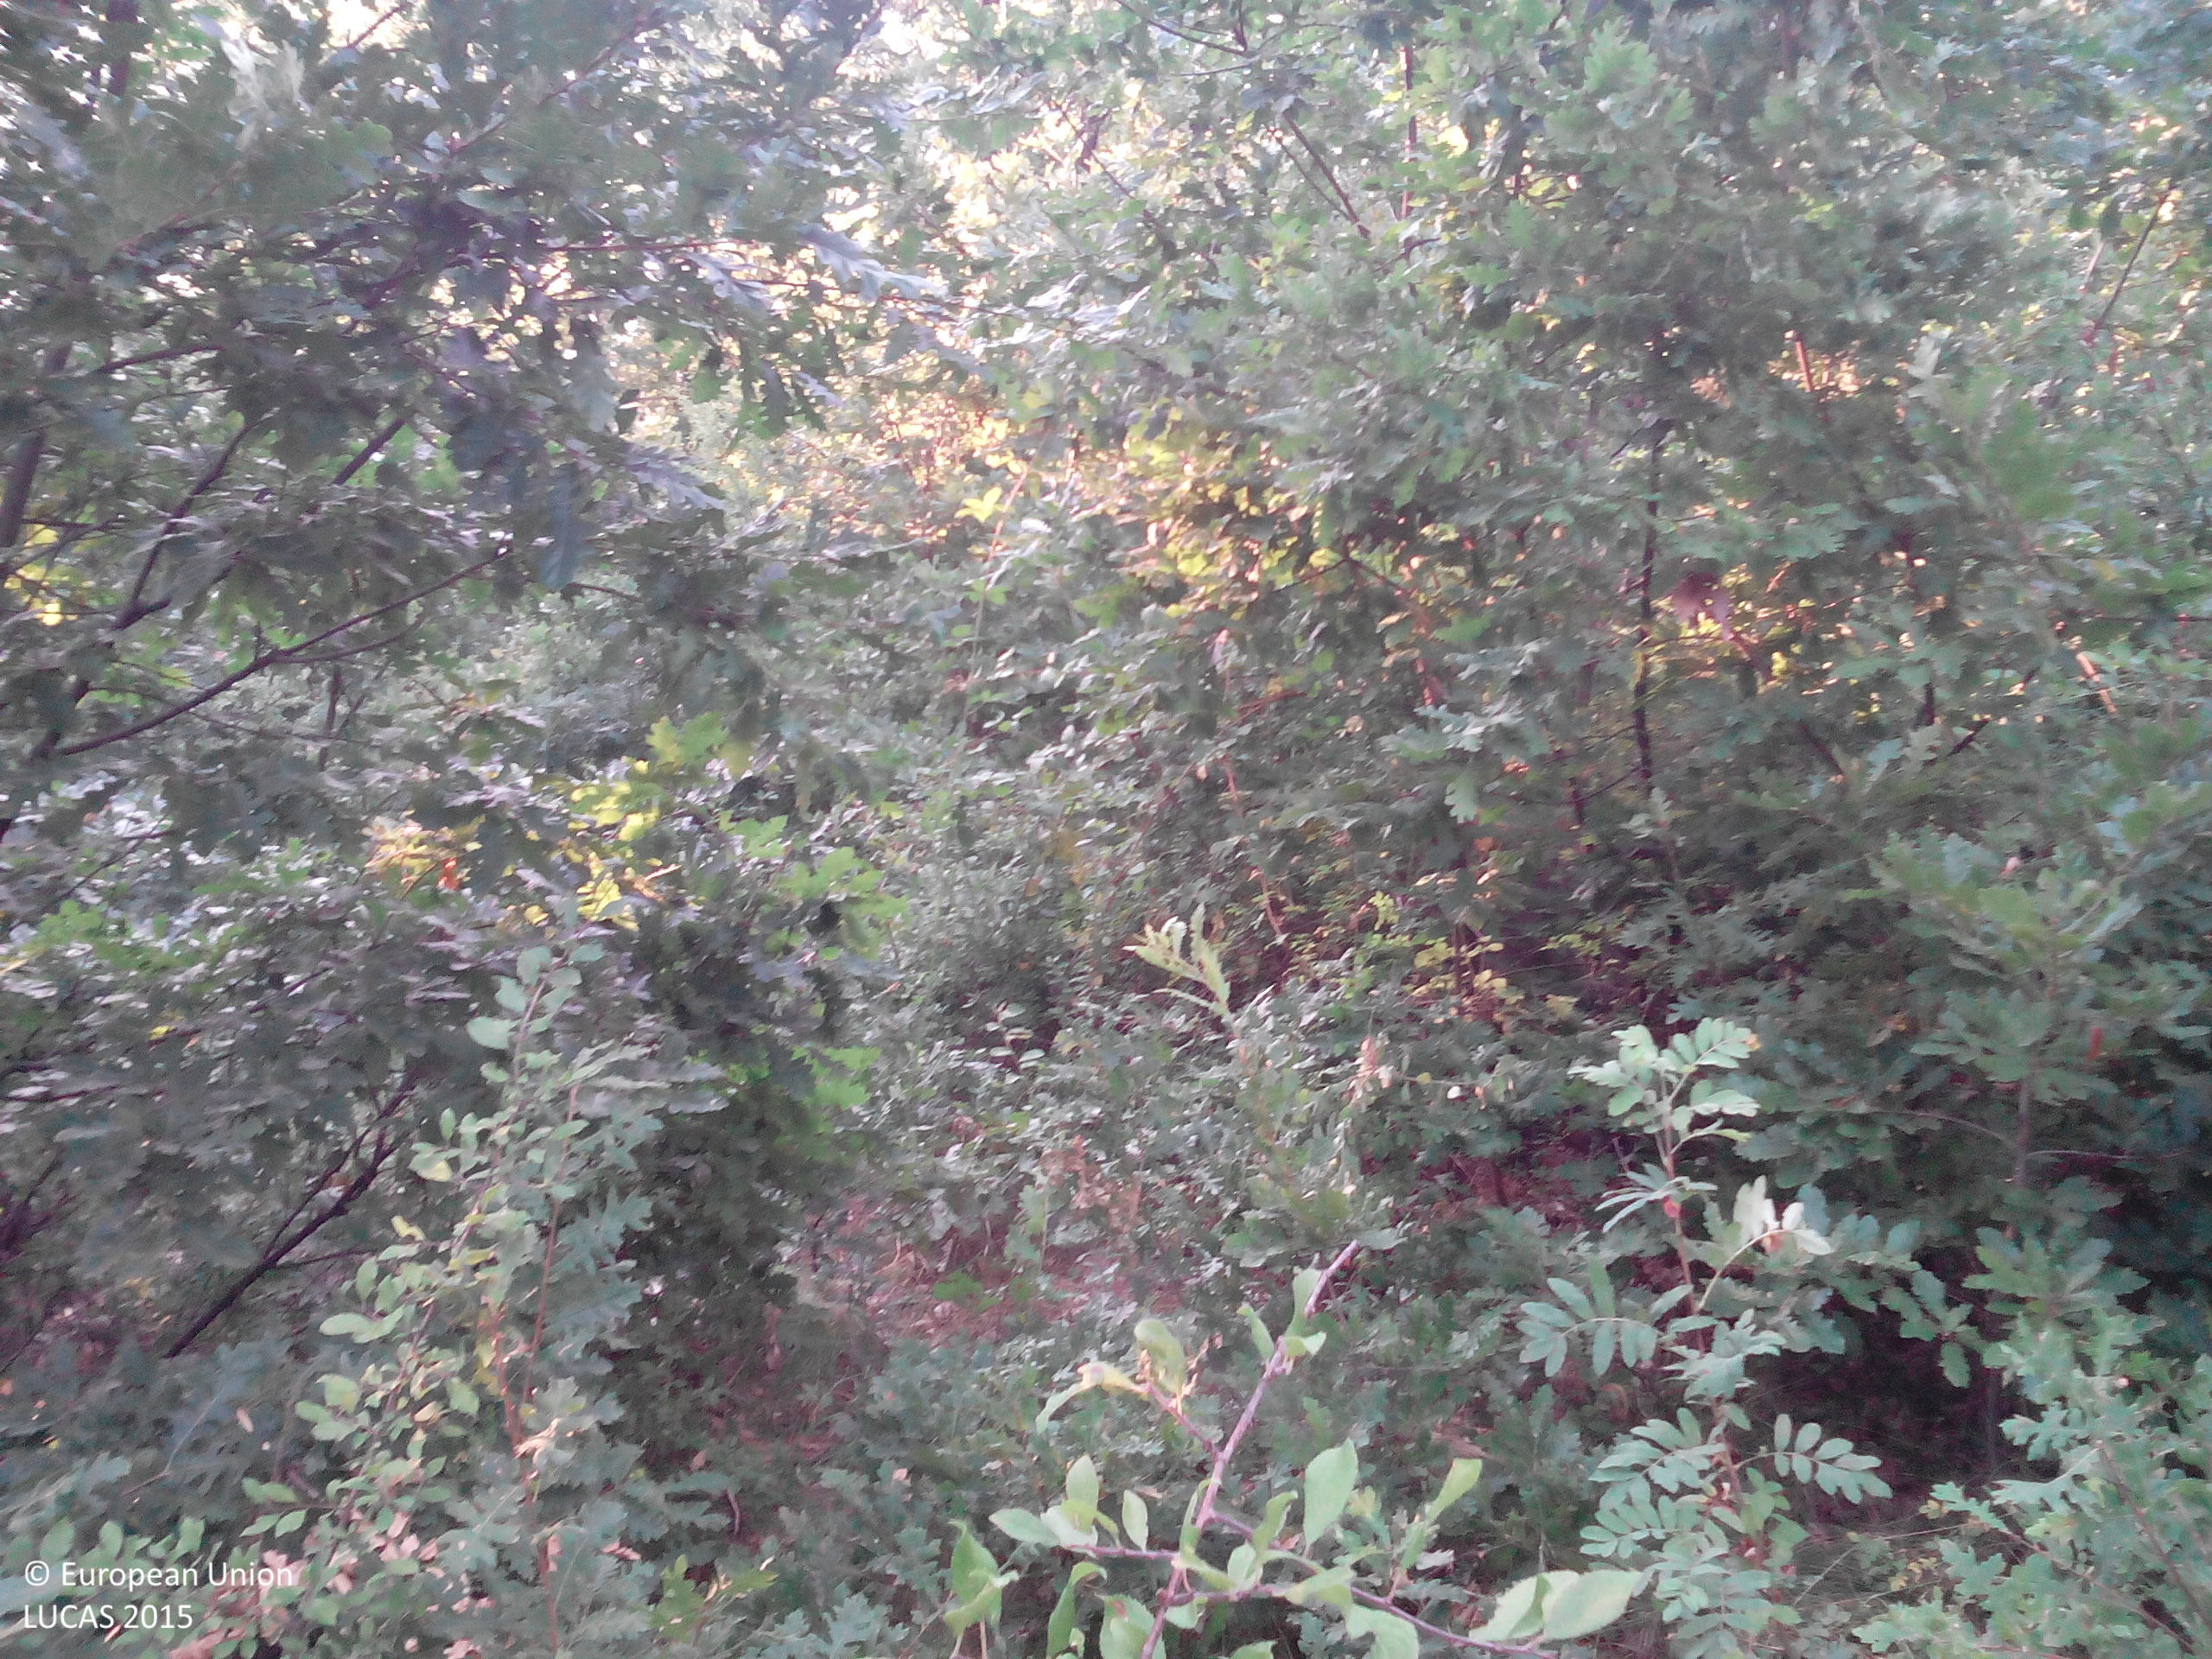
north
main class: Woodland
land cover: Broadleaved woodland
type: acidophilous oak and oak-birch forest
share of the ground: > 75 %
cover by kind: broadleaved forest trees 90 %, shrubs 5 %, herbaceous plants 5 %
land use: Forestry
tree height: > 5 m
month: July
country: BG
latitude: 43.2437
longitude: 24.3046
